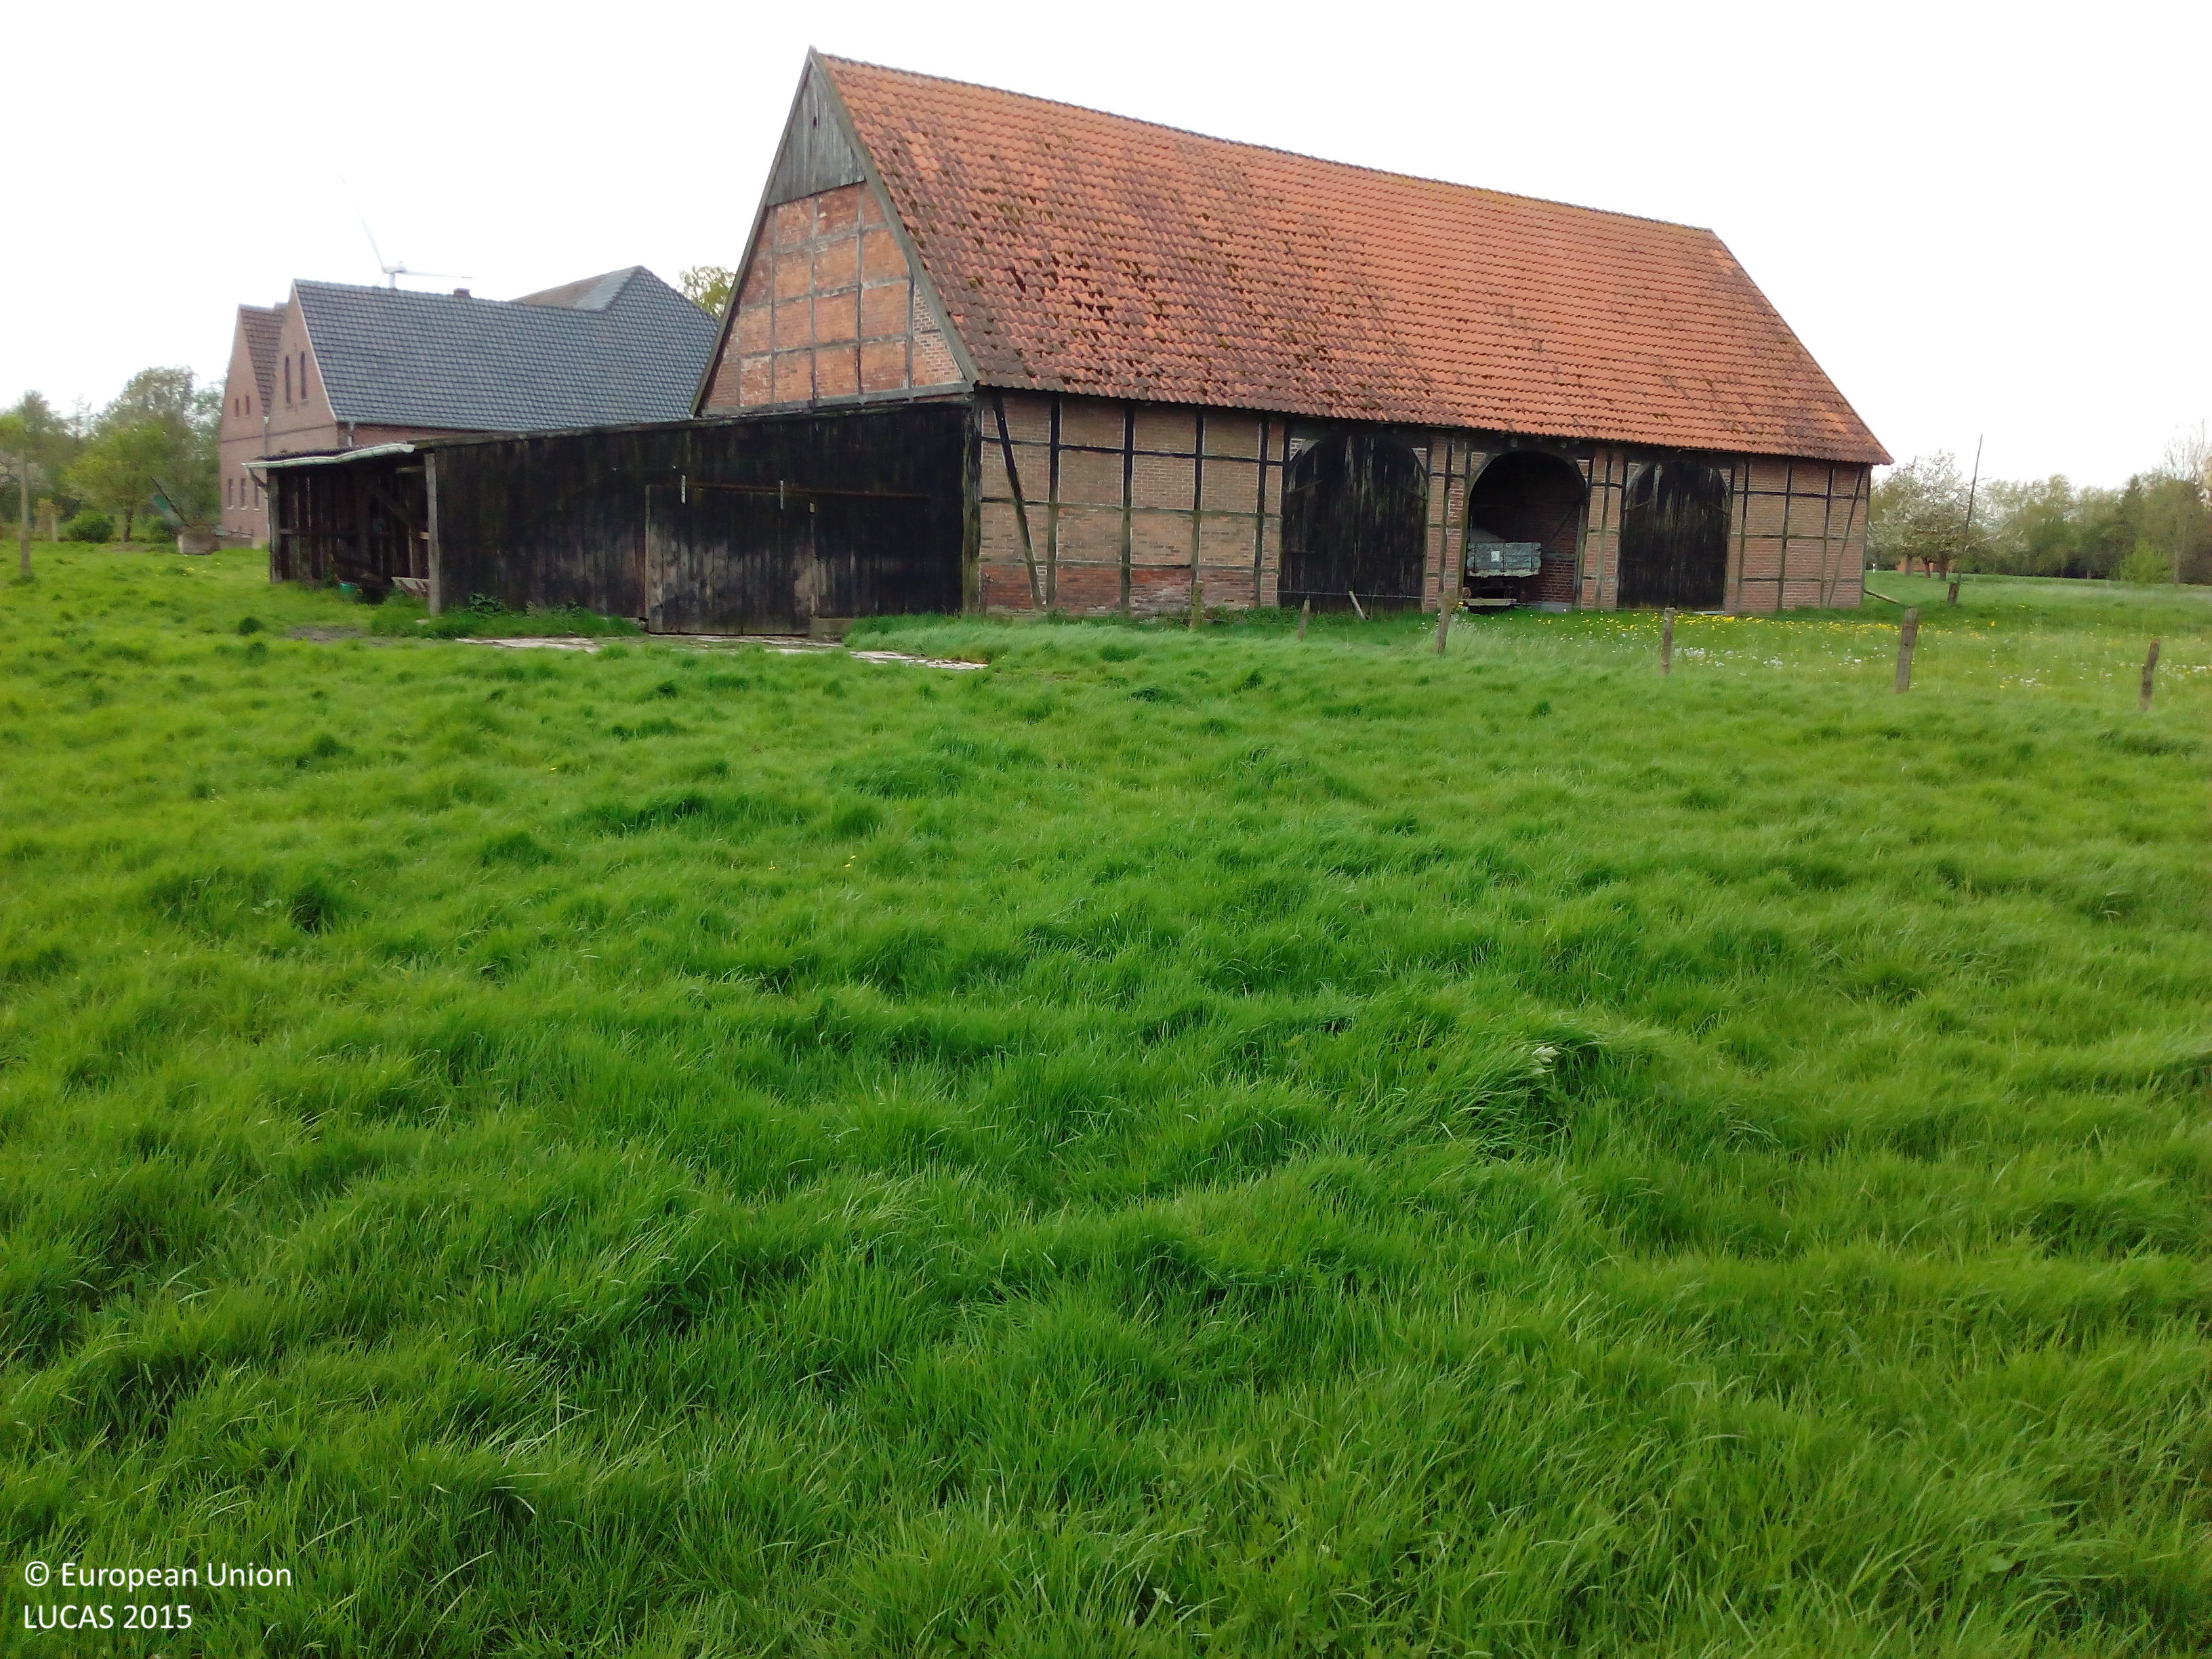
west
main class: Grassland
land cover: Grassland without tree/shrub cover
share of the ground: > 75 %
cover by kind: herbaceous plants 100 %
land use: Agriculture (excluding fallow land and kitchen gardens)
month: May
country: DE
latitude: 52.0264
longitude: 7.4498
